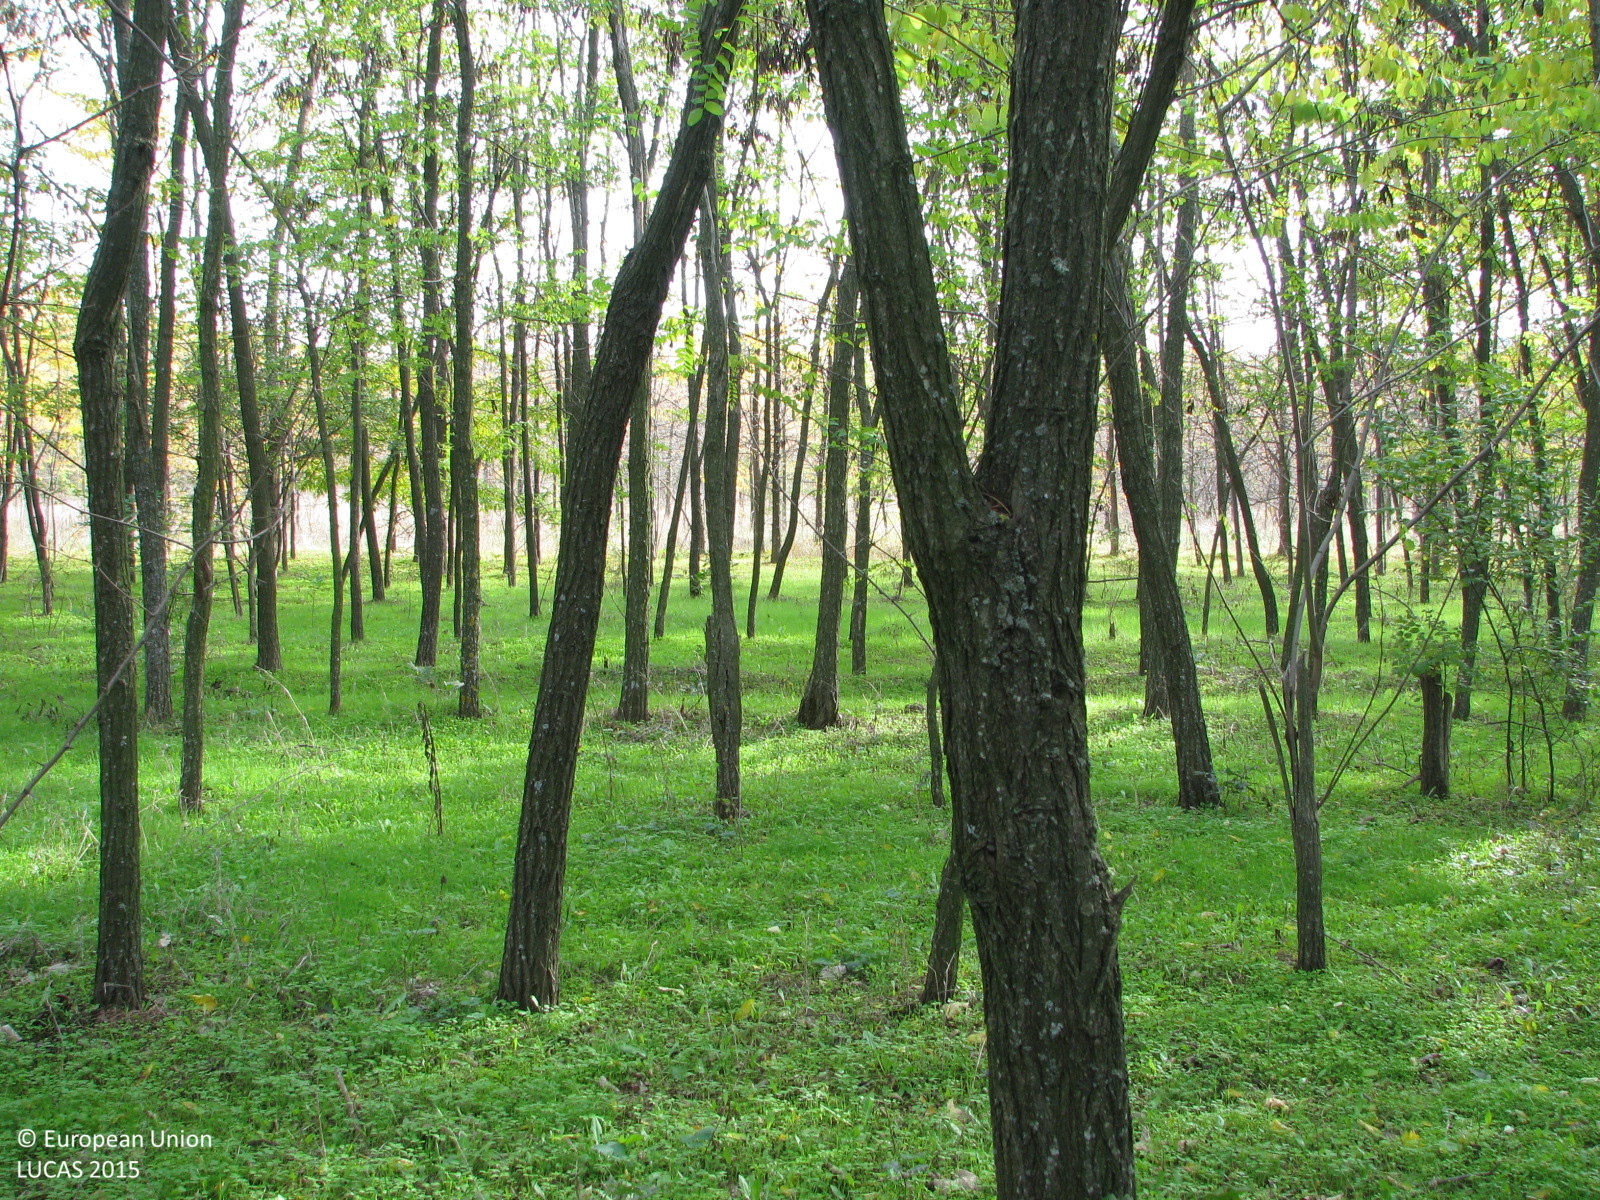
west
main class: Woodland
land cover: Broadleaved woodland
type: mesophytic deciduous forest
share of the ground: 50 - 75 %
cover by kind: broadleaved forest trees 70 %, herbaceous plants 30 %
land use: Forestry
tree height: > 5 m
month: October
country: BG
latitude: 42.4707
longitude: 26.6990
